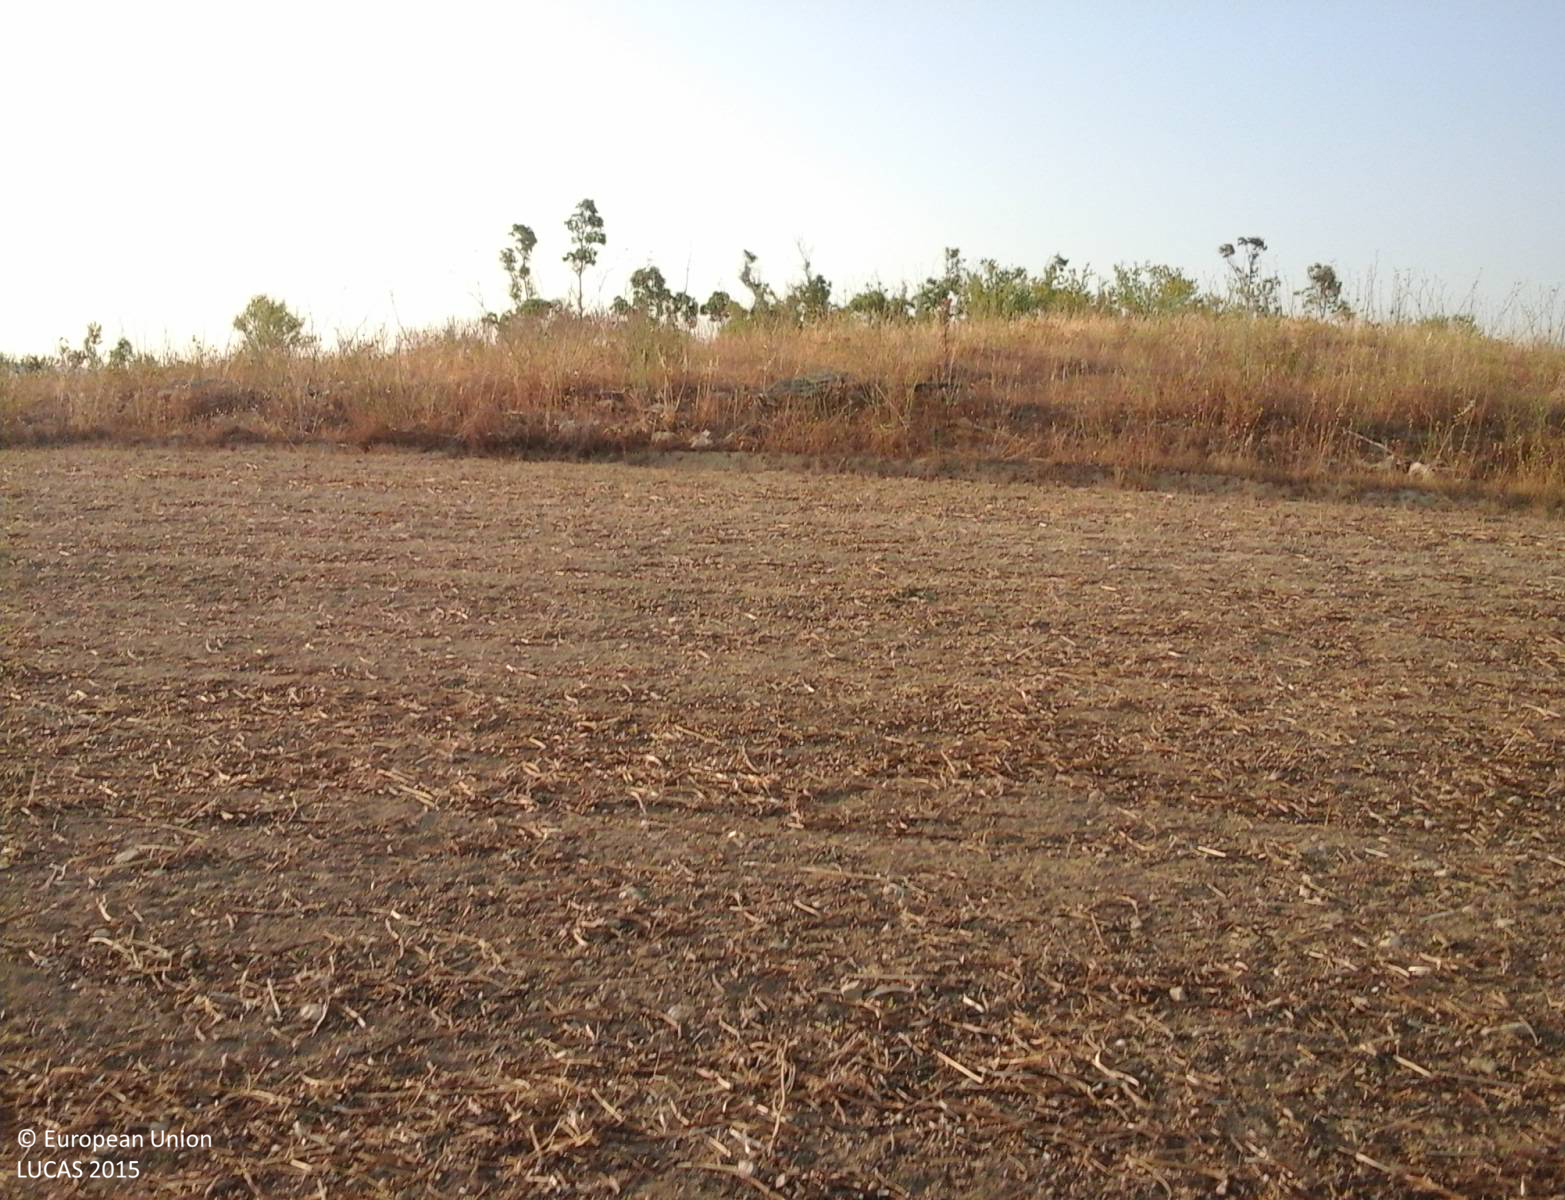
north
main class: Cropland
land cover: Dry pulses
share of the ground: > 75 %
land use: Agriculture (excluding fallow land and kitchen gardens)
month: July
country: IT
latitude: 39.6998
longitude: 8.8984
